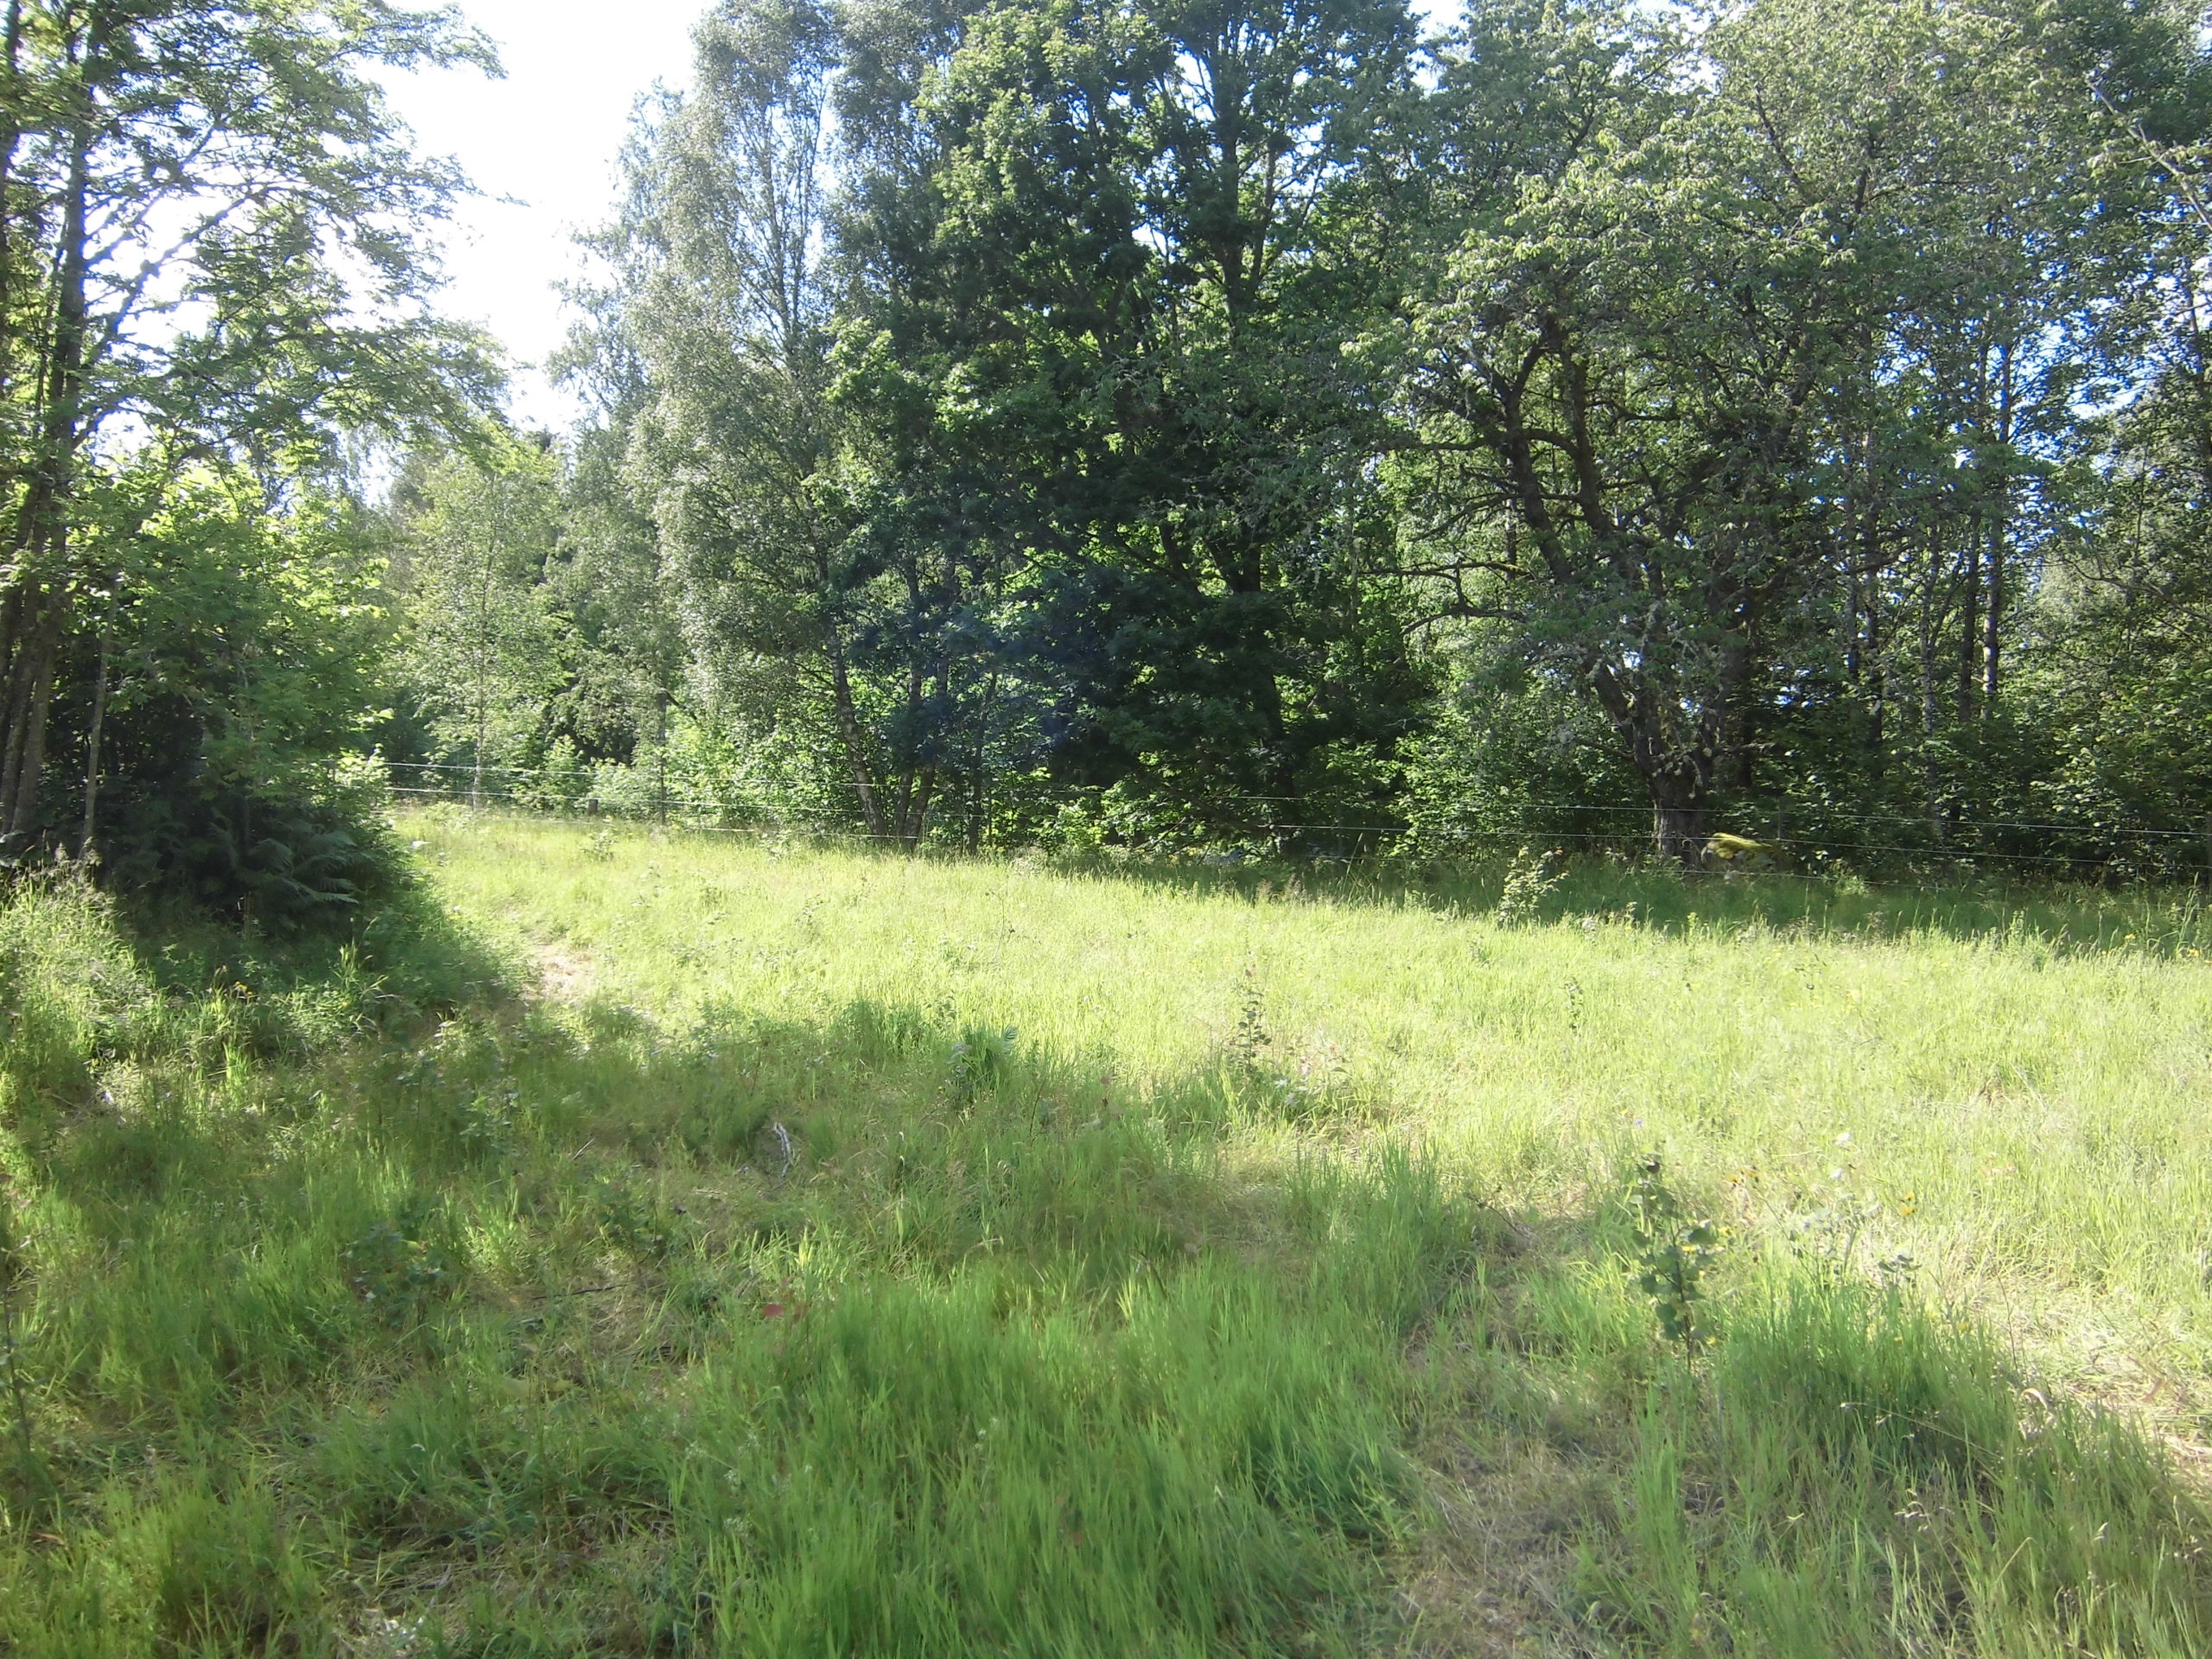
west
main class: Grassland
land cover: Grassland with sparse tree/shrub cover
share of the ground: > 75 %
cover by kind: herbaceous plants 95 %, broadleaved forest trees 5 %
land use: Agriculture (excluding fallow land and kitchen gardens)
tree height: < 5 m
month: July
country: SE
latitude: 57.2119
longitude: 15.3451
